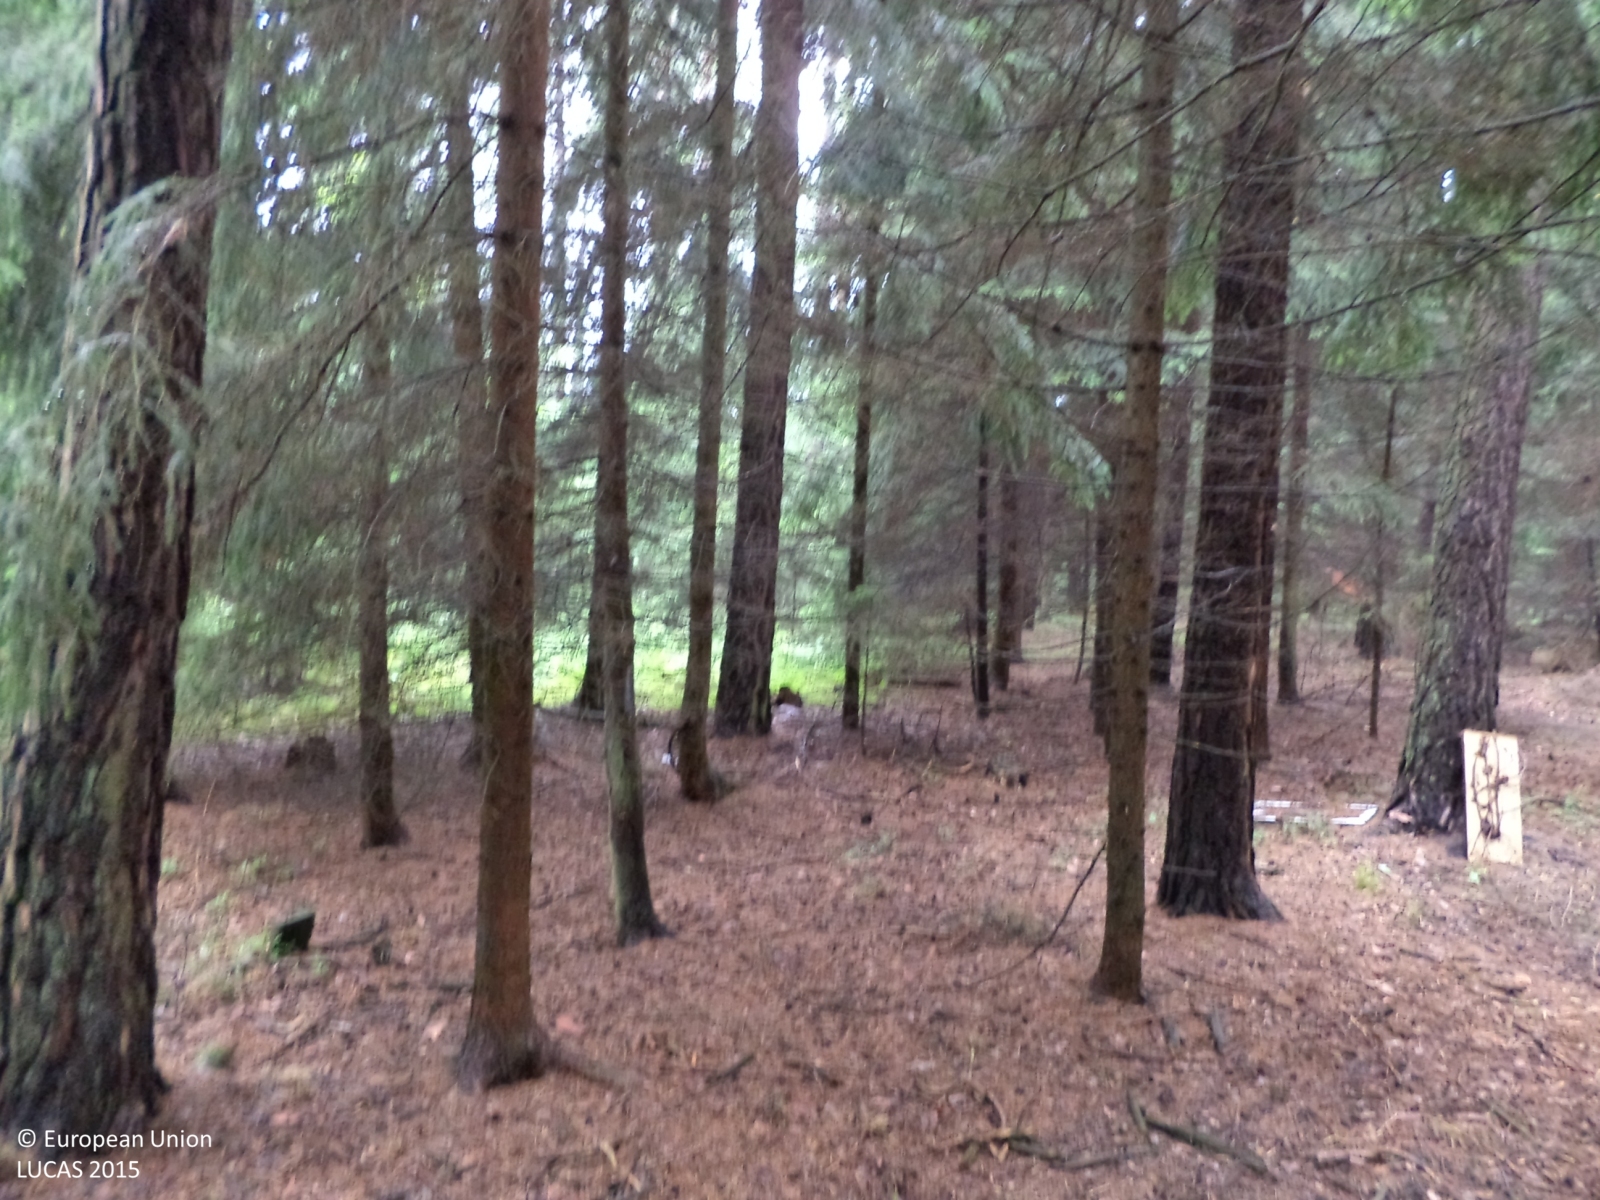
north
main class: Woodland
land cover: Spruce dominated coniferous woodland
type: hemiboreal forest and nemoral coniferous forest and mixed broadleaved-coniferous forest
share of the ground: > 75 %
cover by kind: coniferous forest trees 95 %, herbaceous plants 5 %
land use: Forestry
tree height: > 5 m
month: June
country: CZ
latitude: 49.2007
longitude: 14.3516
